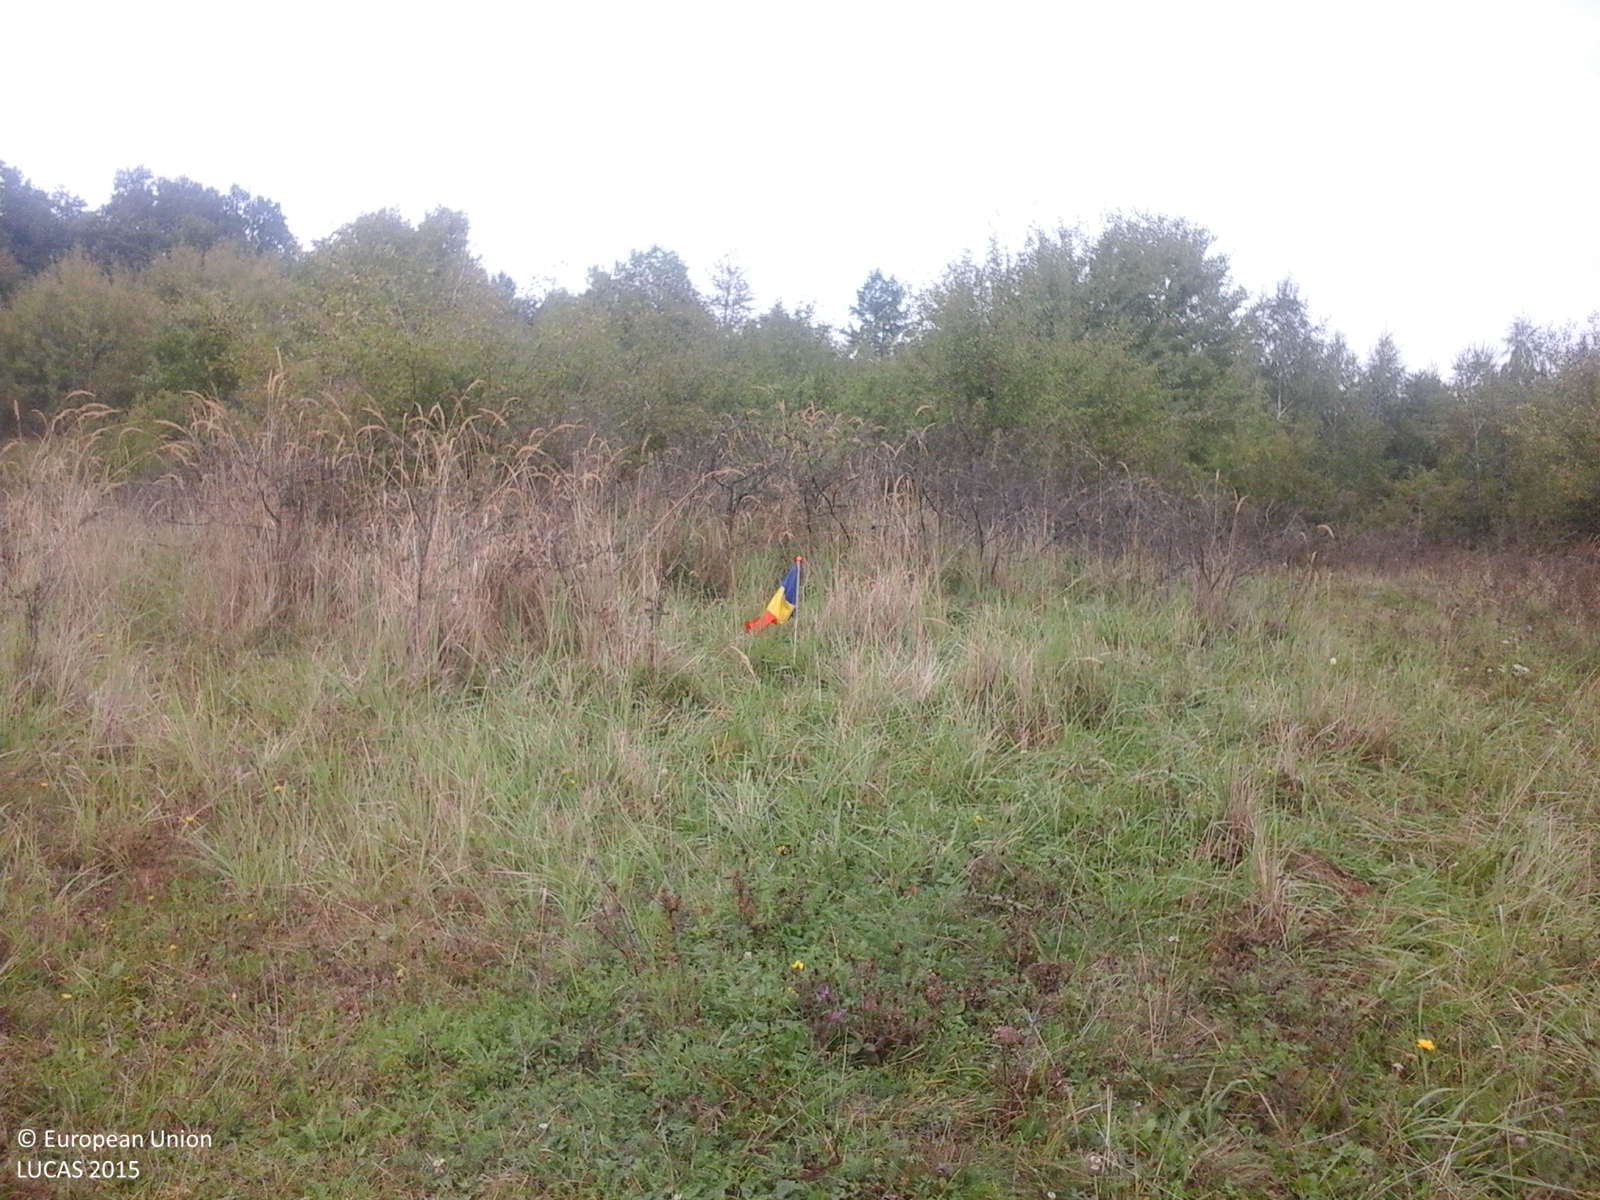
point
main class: Grassland
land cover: Grassland with sparse tree/shrub cover
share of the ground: > 75 %
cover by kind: herbaceous plants 85 %, shrubs 10 %, broadleaved forest trees 5 %
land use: Fallow land
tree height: < 5 m
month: September
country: RO
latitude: 46.9448
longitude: 22.4953
